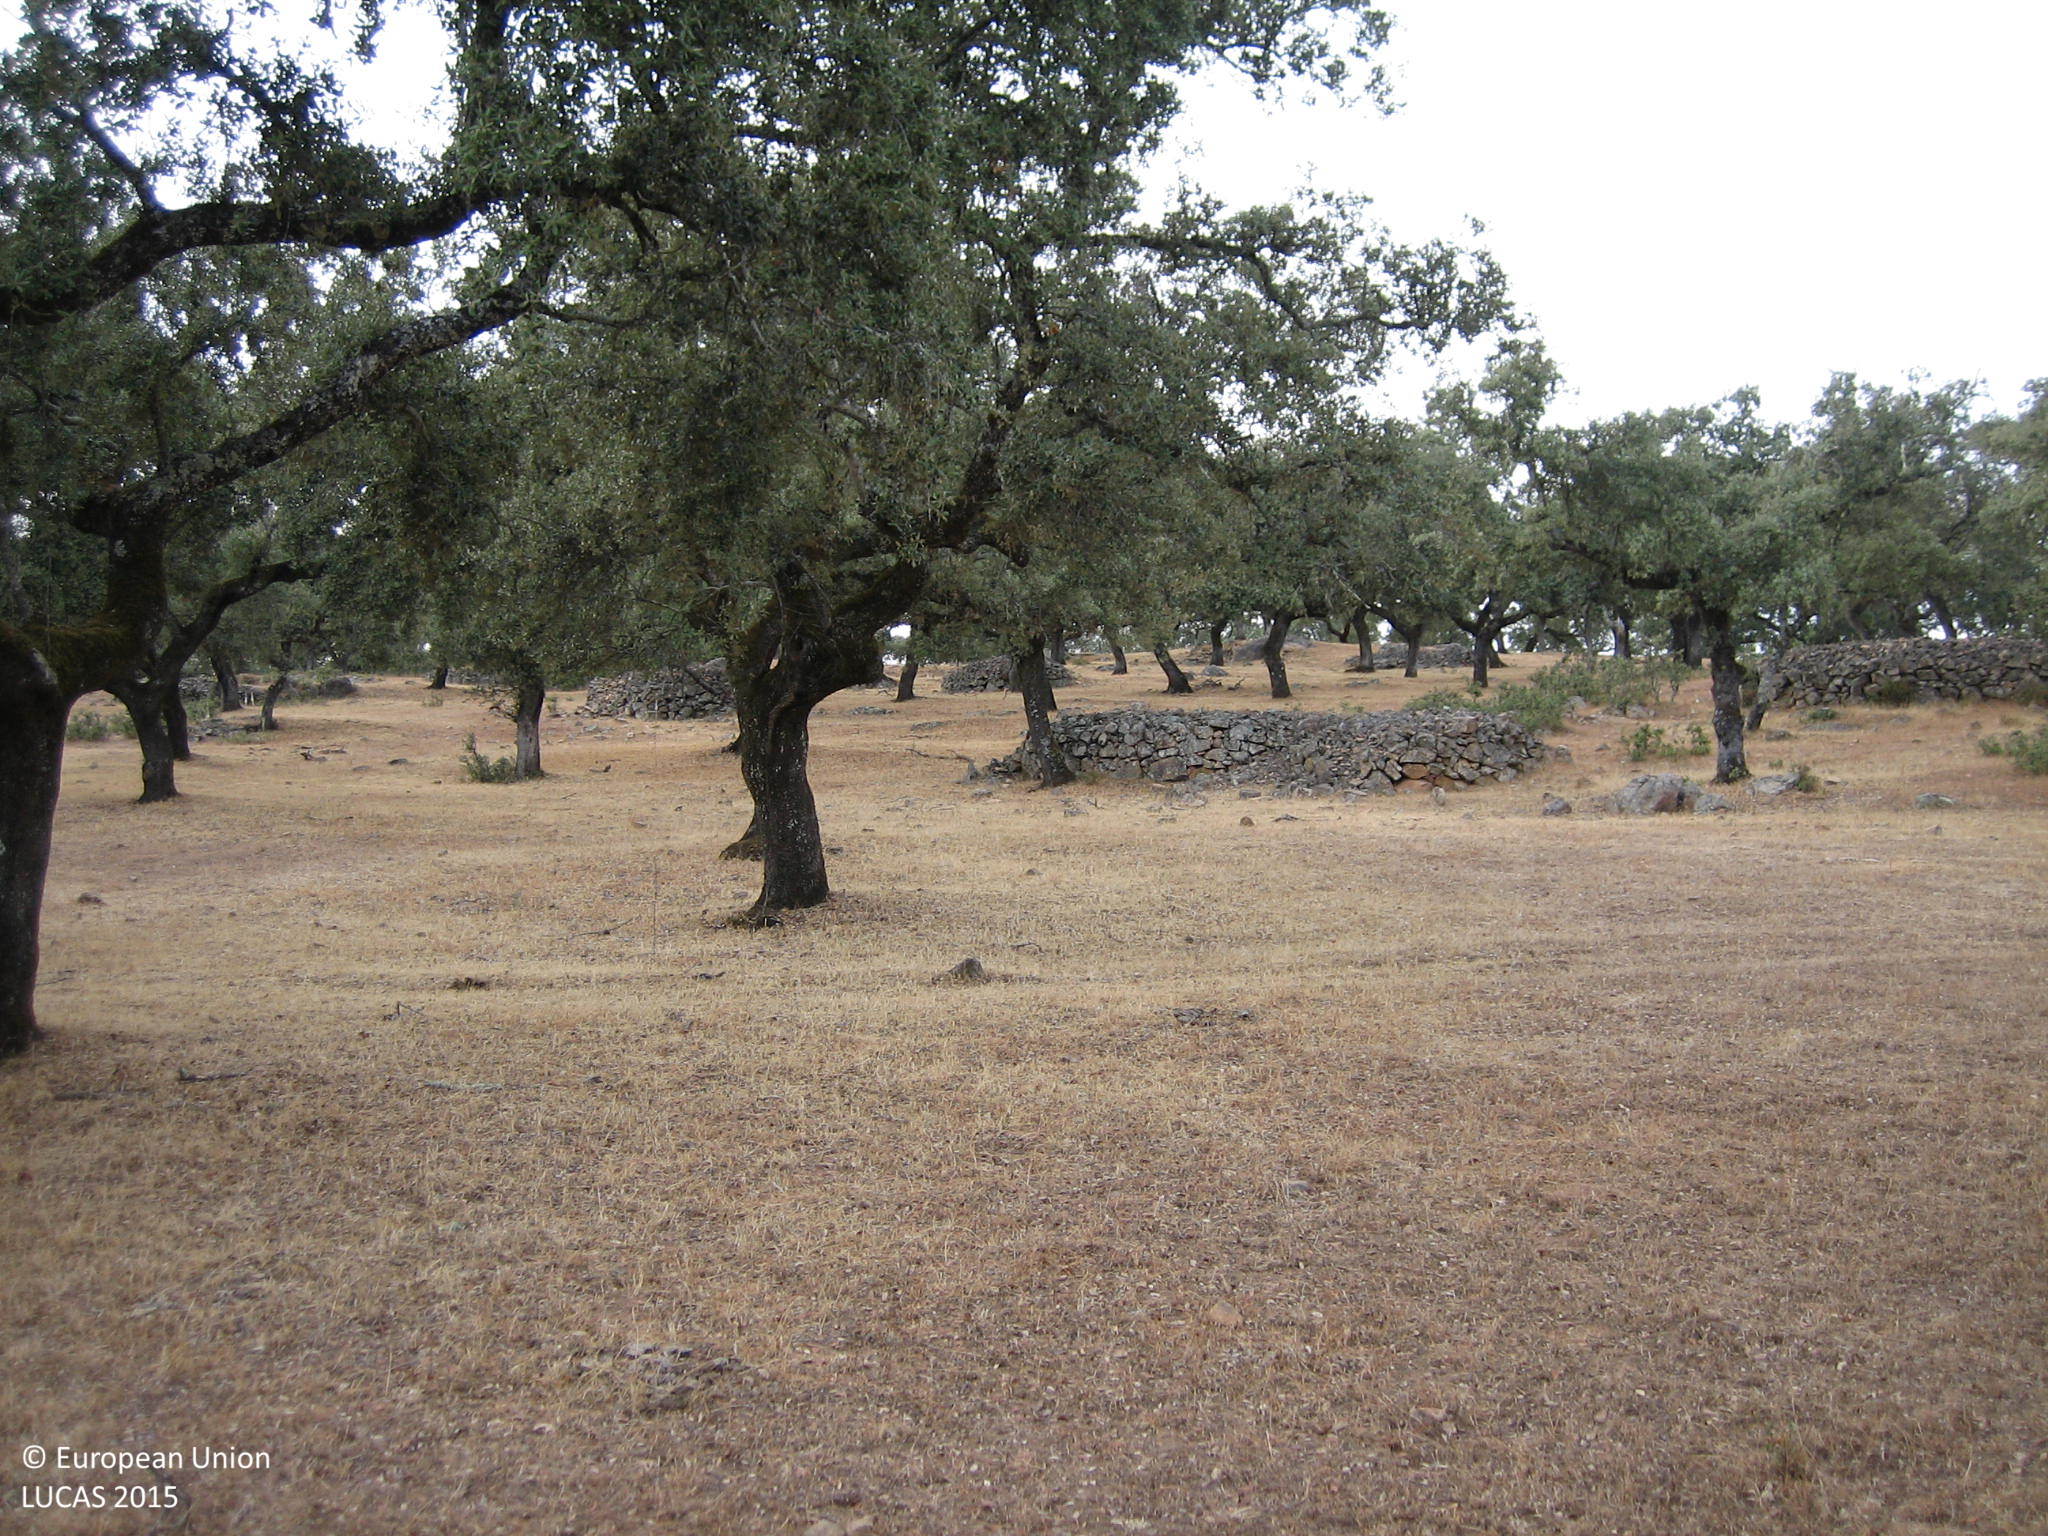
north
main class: Woodland
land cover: Broadleaved woodland
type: broadleaved evergreen forest
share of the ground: 25 - 50 %
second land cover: Grassland without tree/shrub cover
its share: > 75 %
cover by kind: herbaceous plants 60 %, broadleaved forest trees 40 %
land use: Forestry
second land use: Agriculture (excluding fallow land and kitchen gardens)
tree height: > 5 m
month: September
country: ES
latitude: 38.3465
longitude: -6.7962
